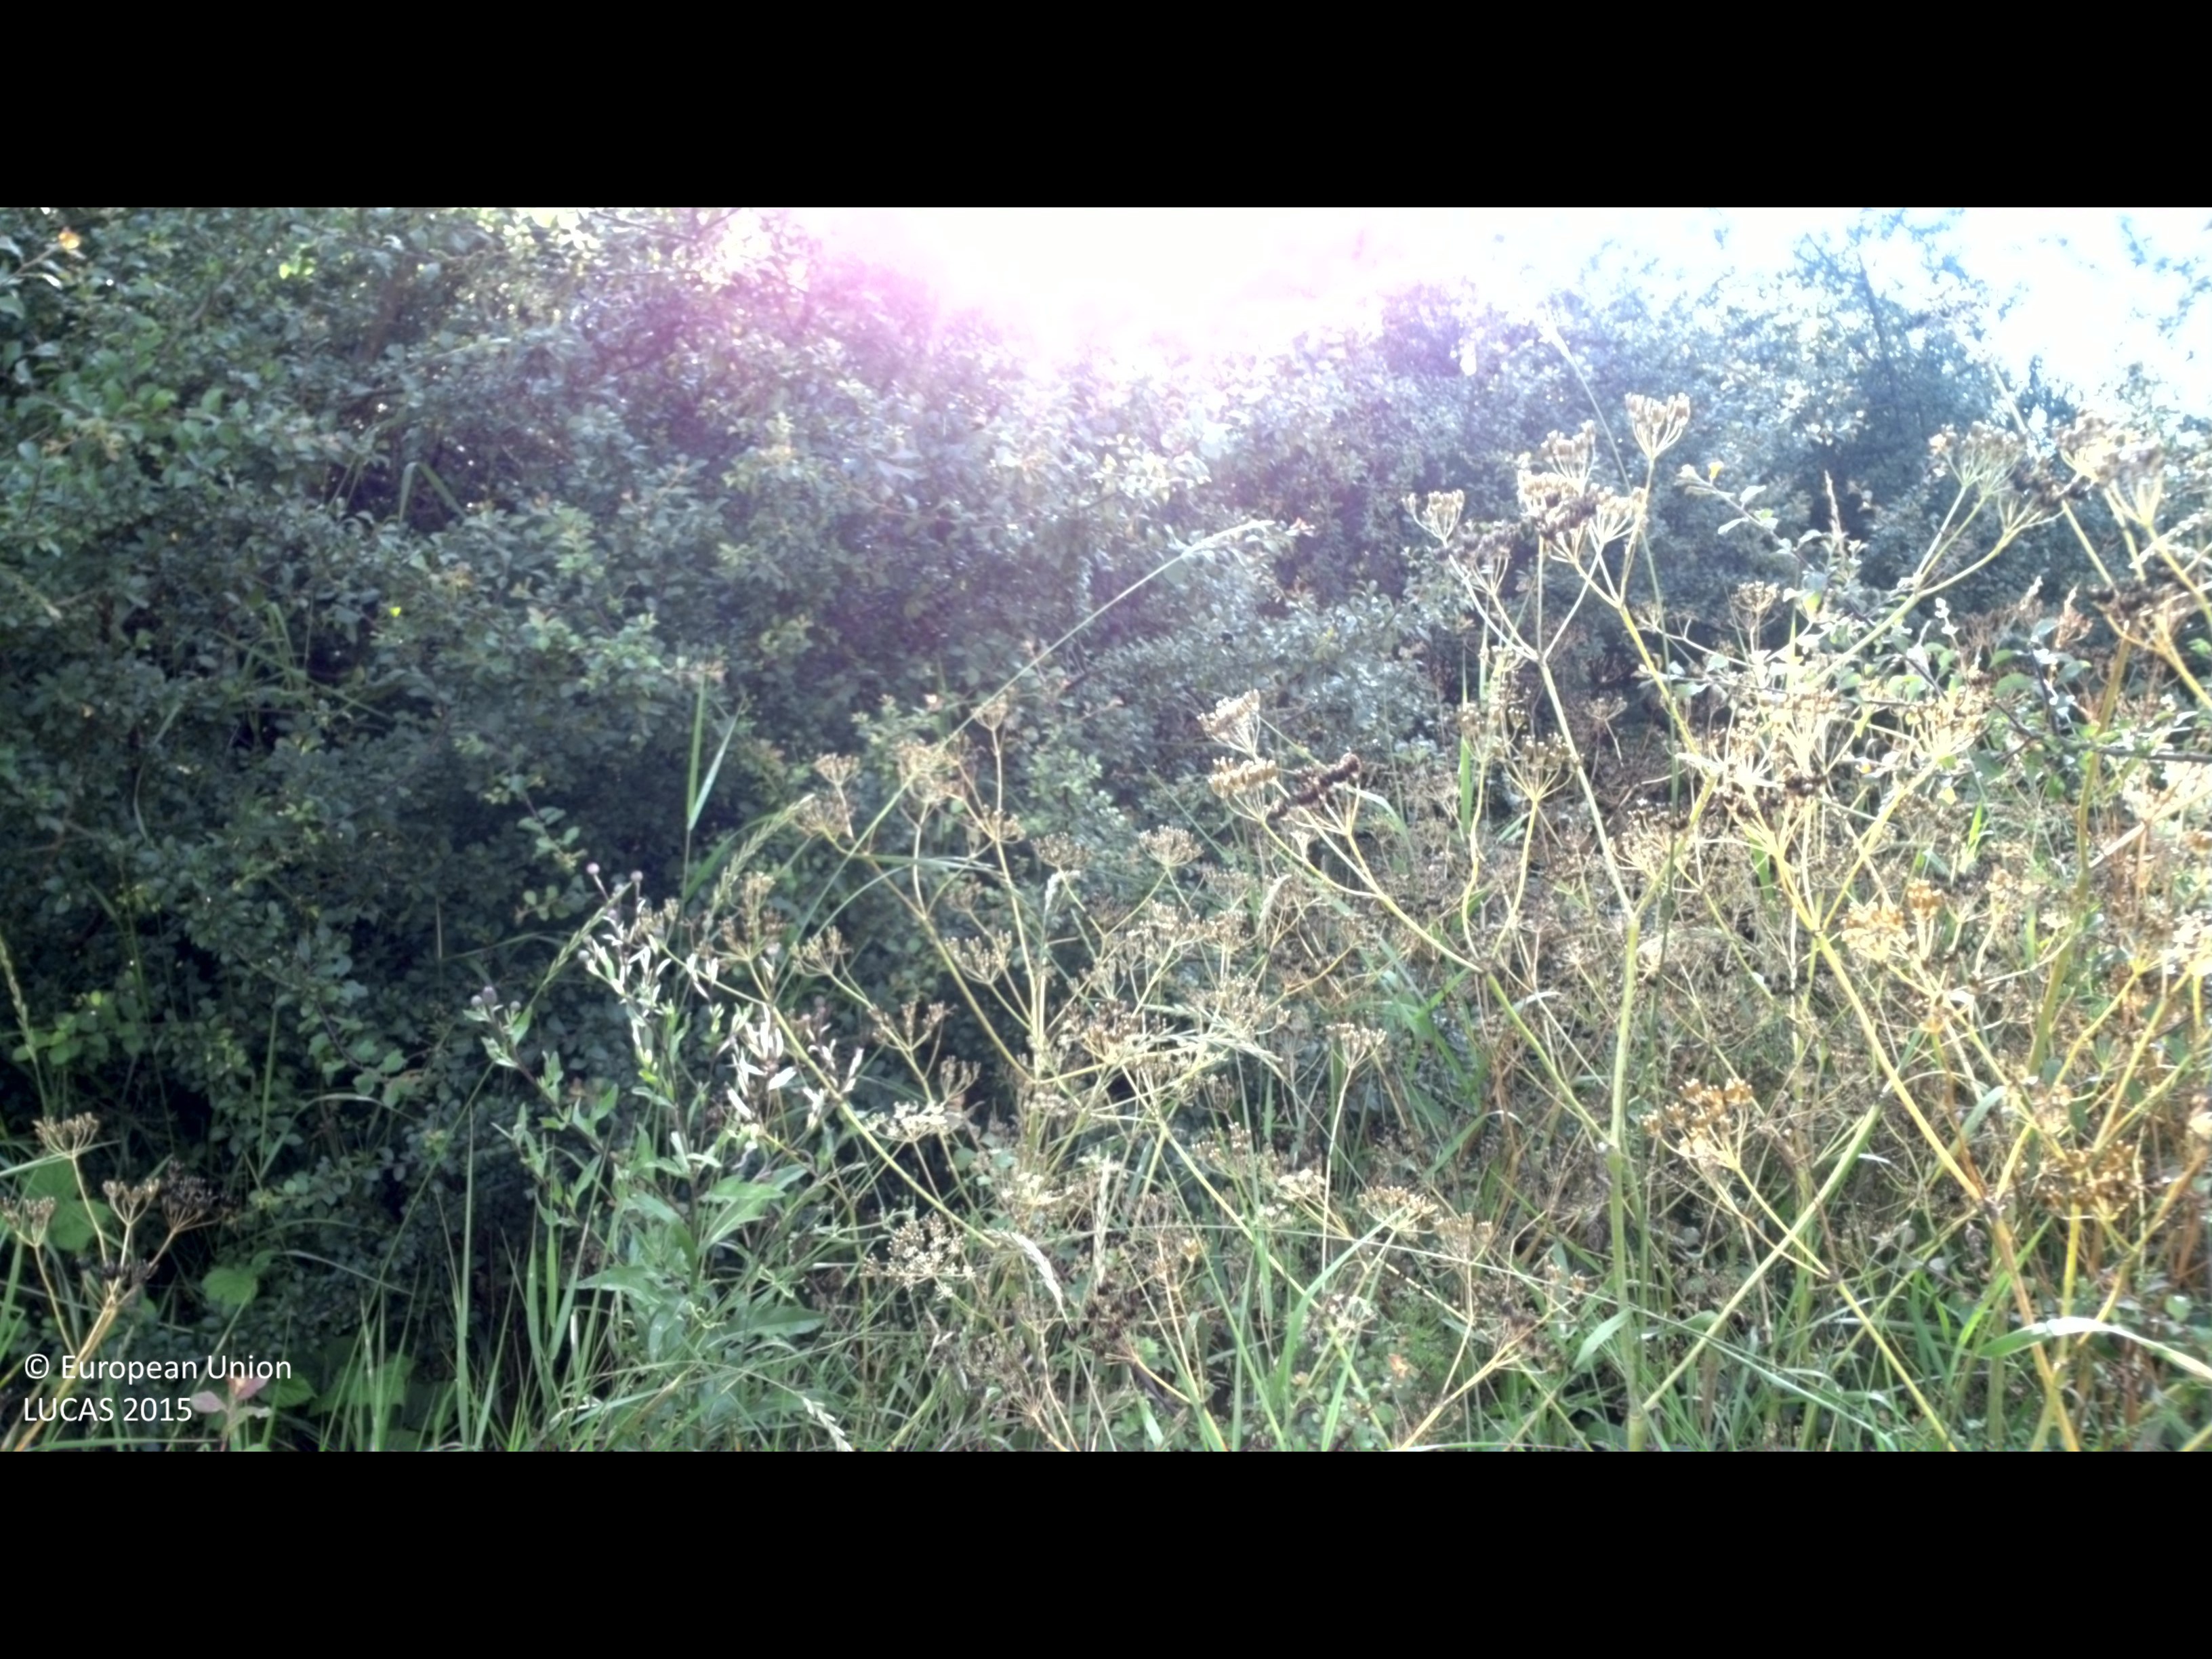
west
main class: Shrubland
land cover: Shrubland without tree cover
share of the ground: > 75 %
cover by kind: shrubs 80 %, herbaceous plants 20 %
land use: Semi-natural and natural areas not in use
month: July
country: SE
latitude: 56.5515
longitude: 16.3944
